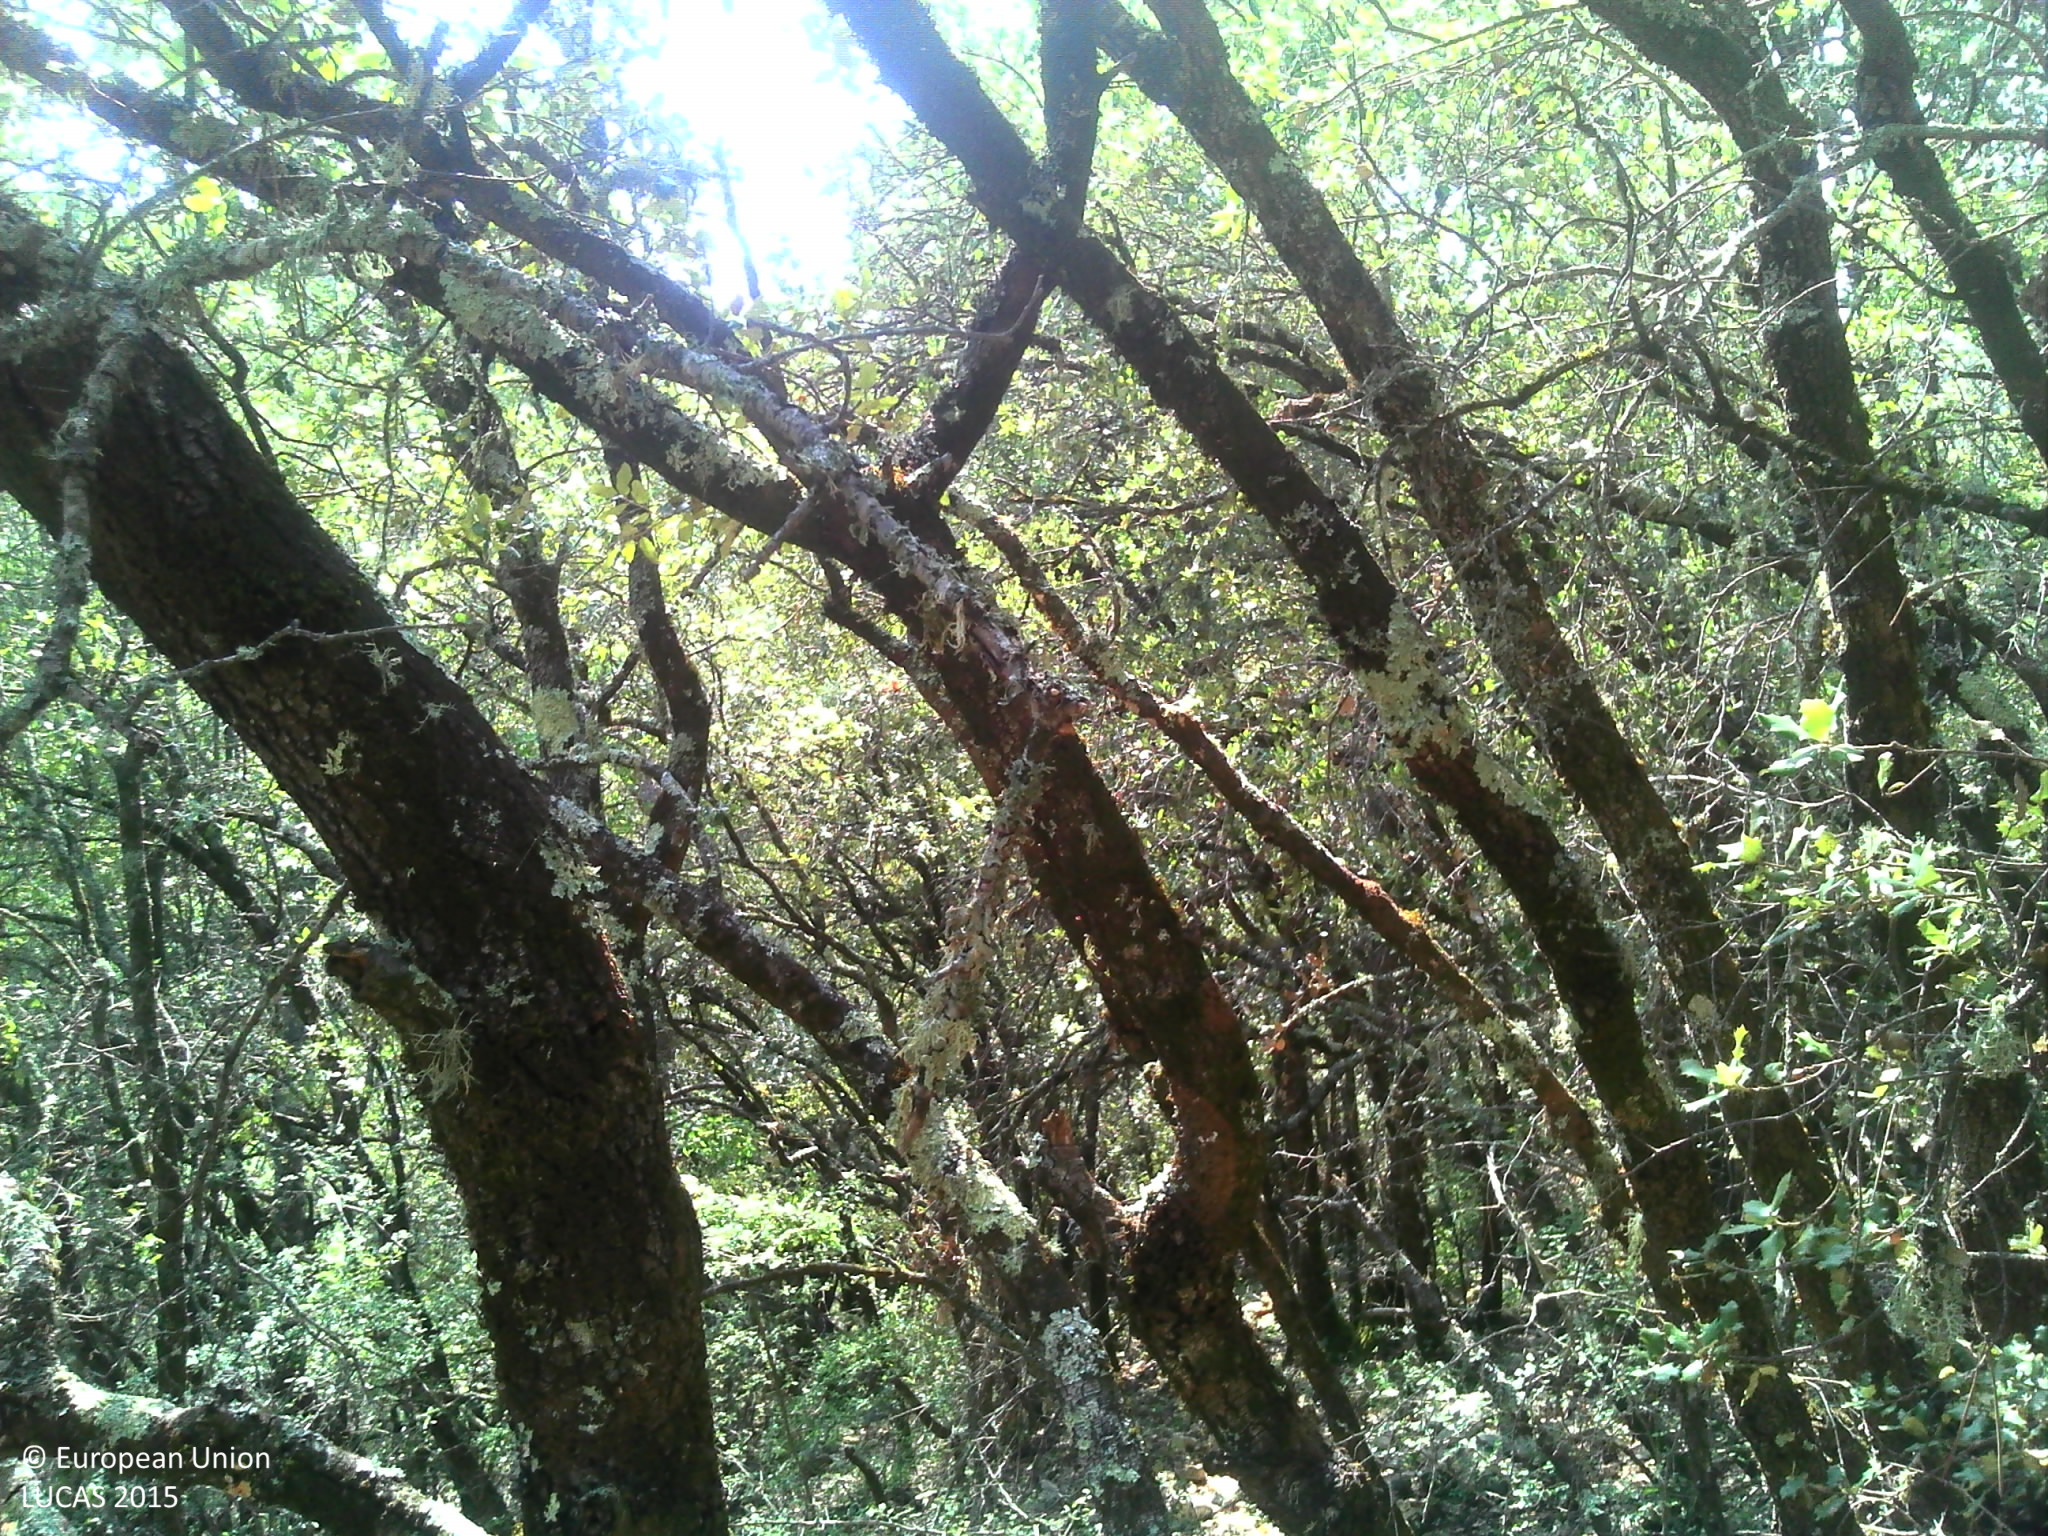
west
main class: Woodland
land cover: Broadleaved woodland
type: thermophilous deciduous forest
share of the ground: > 75 %
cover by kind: broadleaved forest trees 90 %, unconsolidated bare surface 10 %
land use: Semi-natural and natural areas not in use
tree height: > 5 m
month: August
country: FR
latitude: 43.6355
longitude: 6.3270
